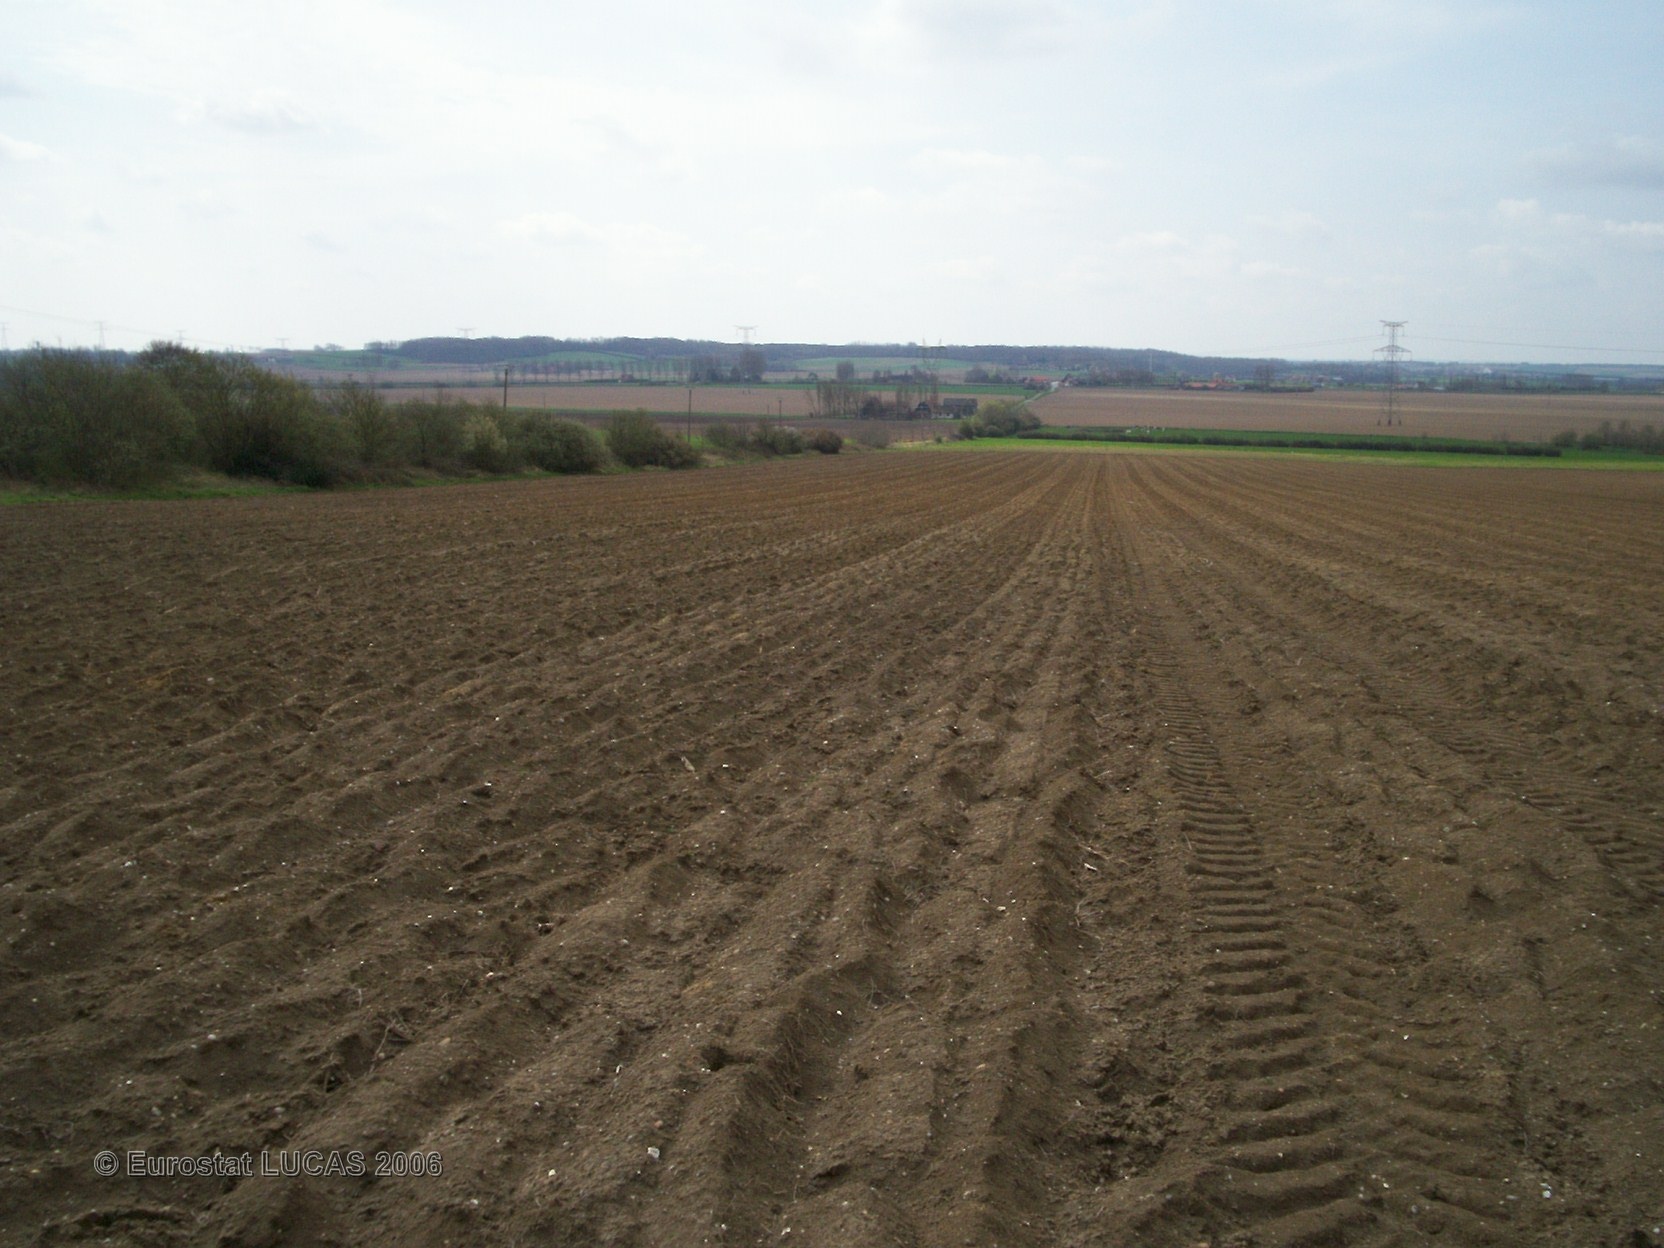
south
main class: Cropland
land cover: Maize
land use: Agriculture (excluding fallow land and kitchen gardens)
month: May
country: FR
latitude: 50.7435
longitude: 2.4049
